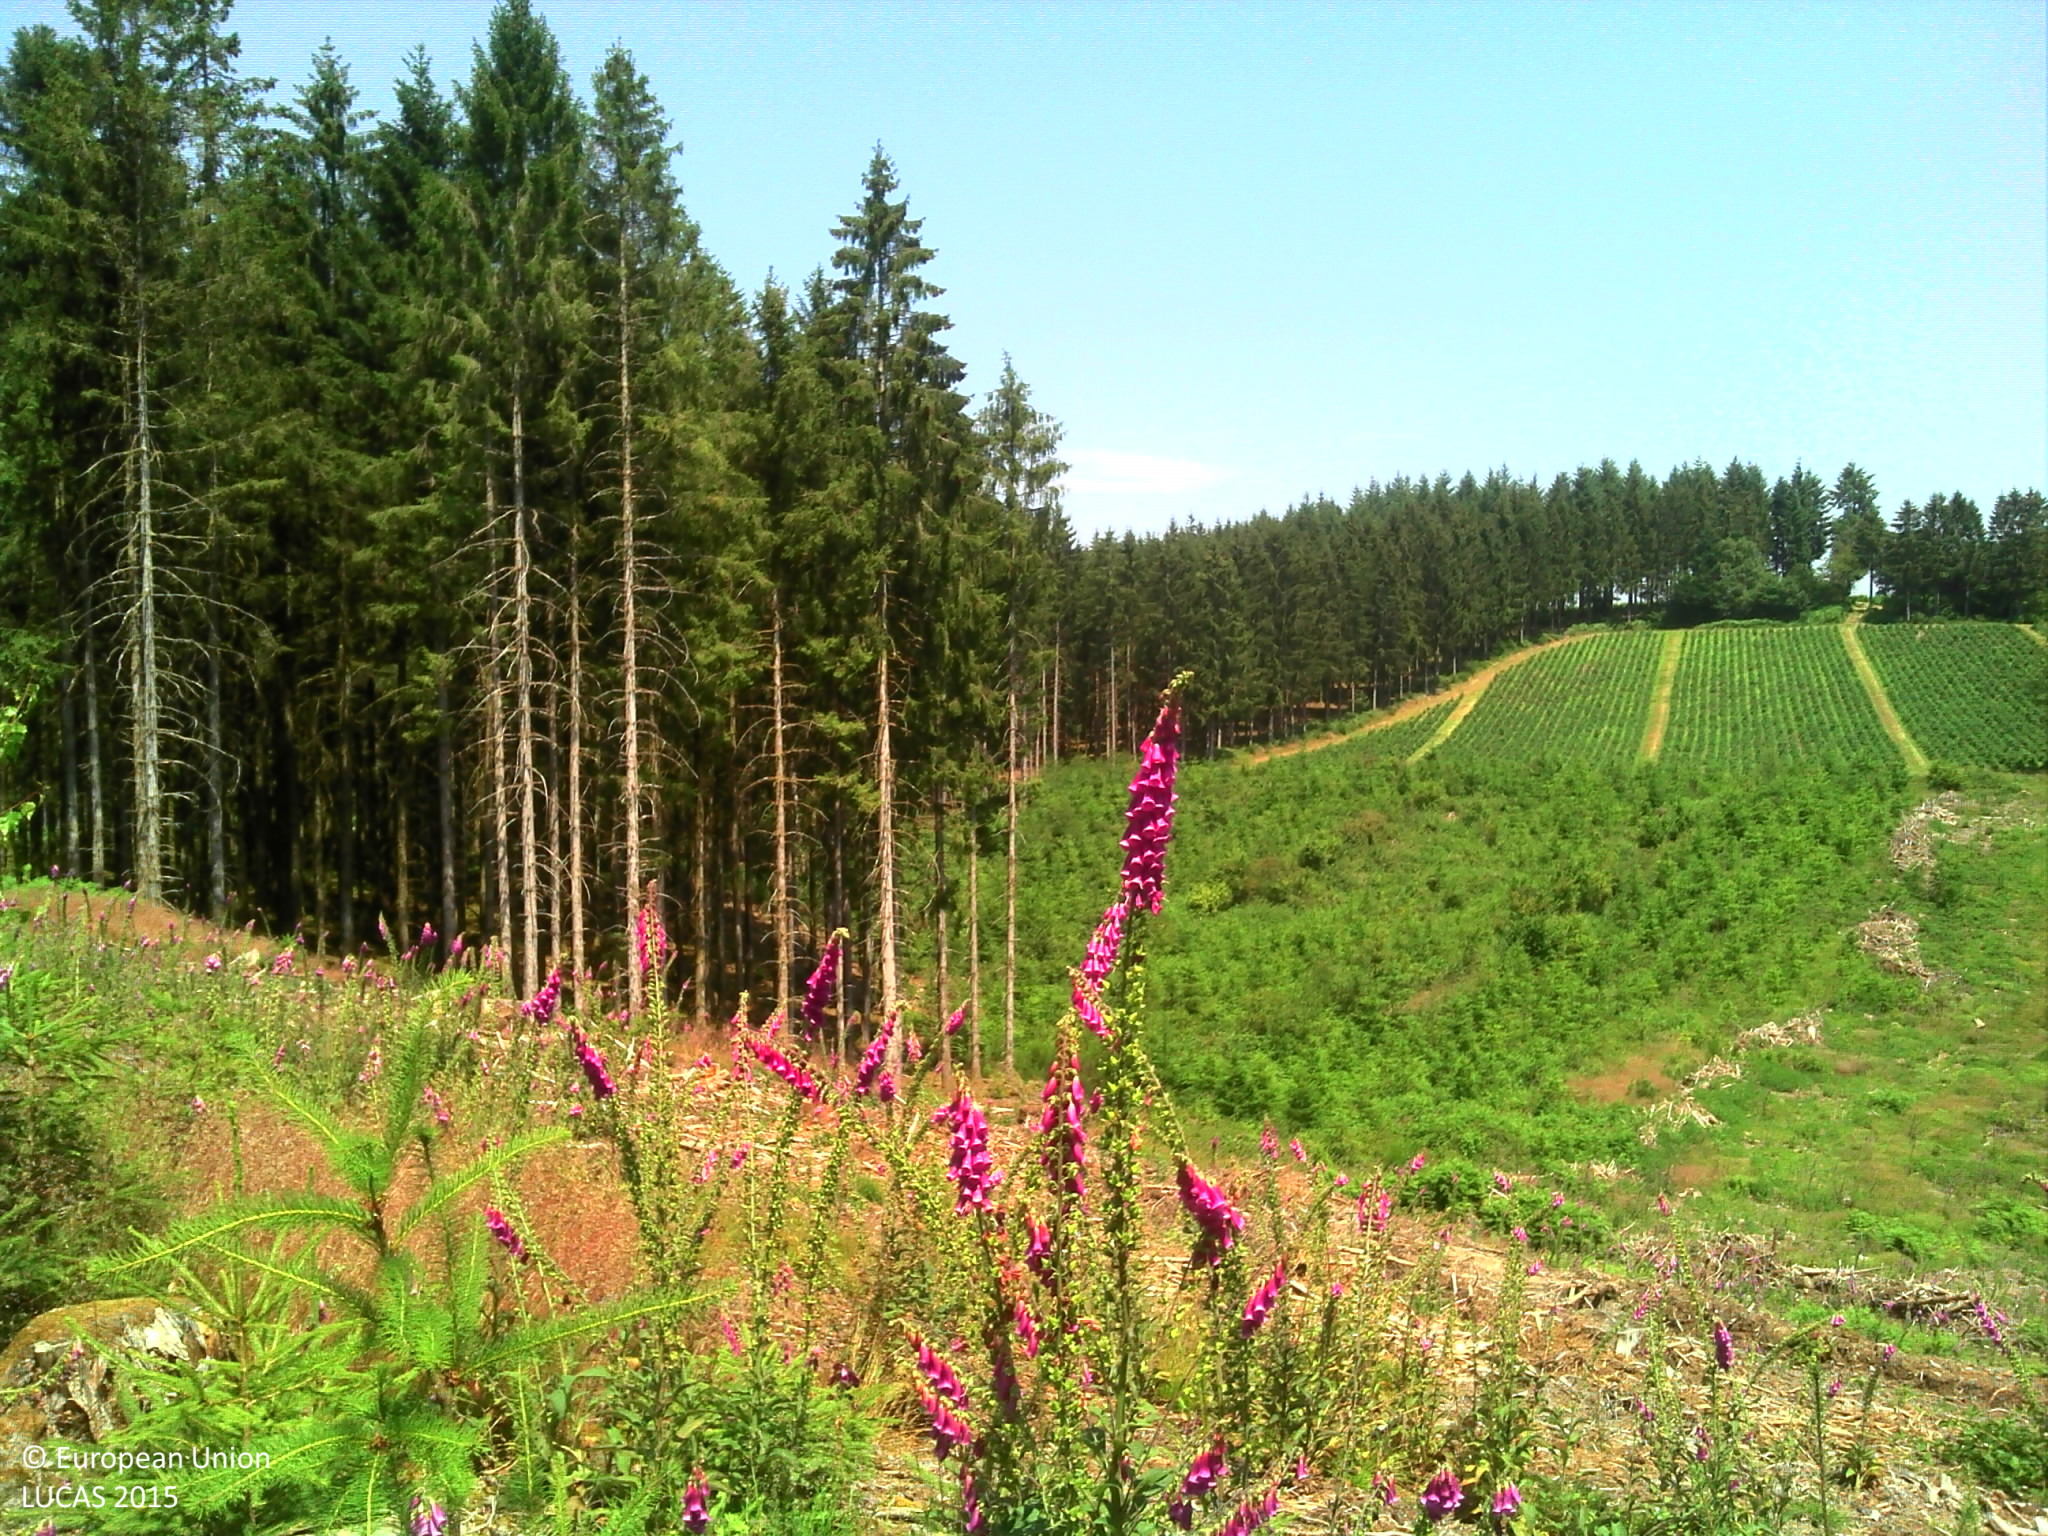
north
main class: Woodland
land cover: Spruce dominated coniferous woodland
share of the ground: > 75 %
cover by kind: coniferous forest trees 100 %
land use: Forestry
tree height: < 5 m
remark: Clear cut
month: July
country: FR
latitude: 47.1397
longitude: 3.9993
